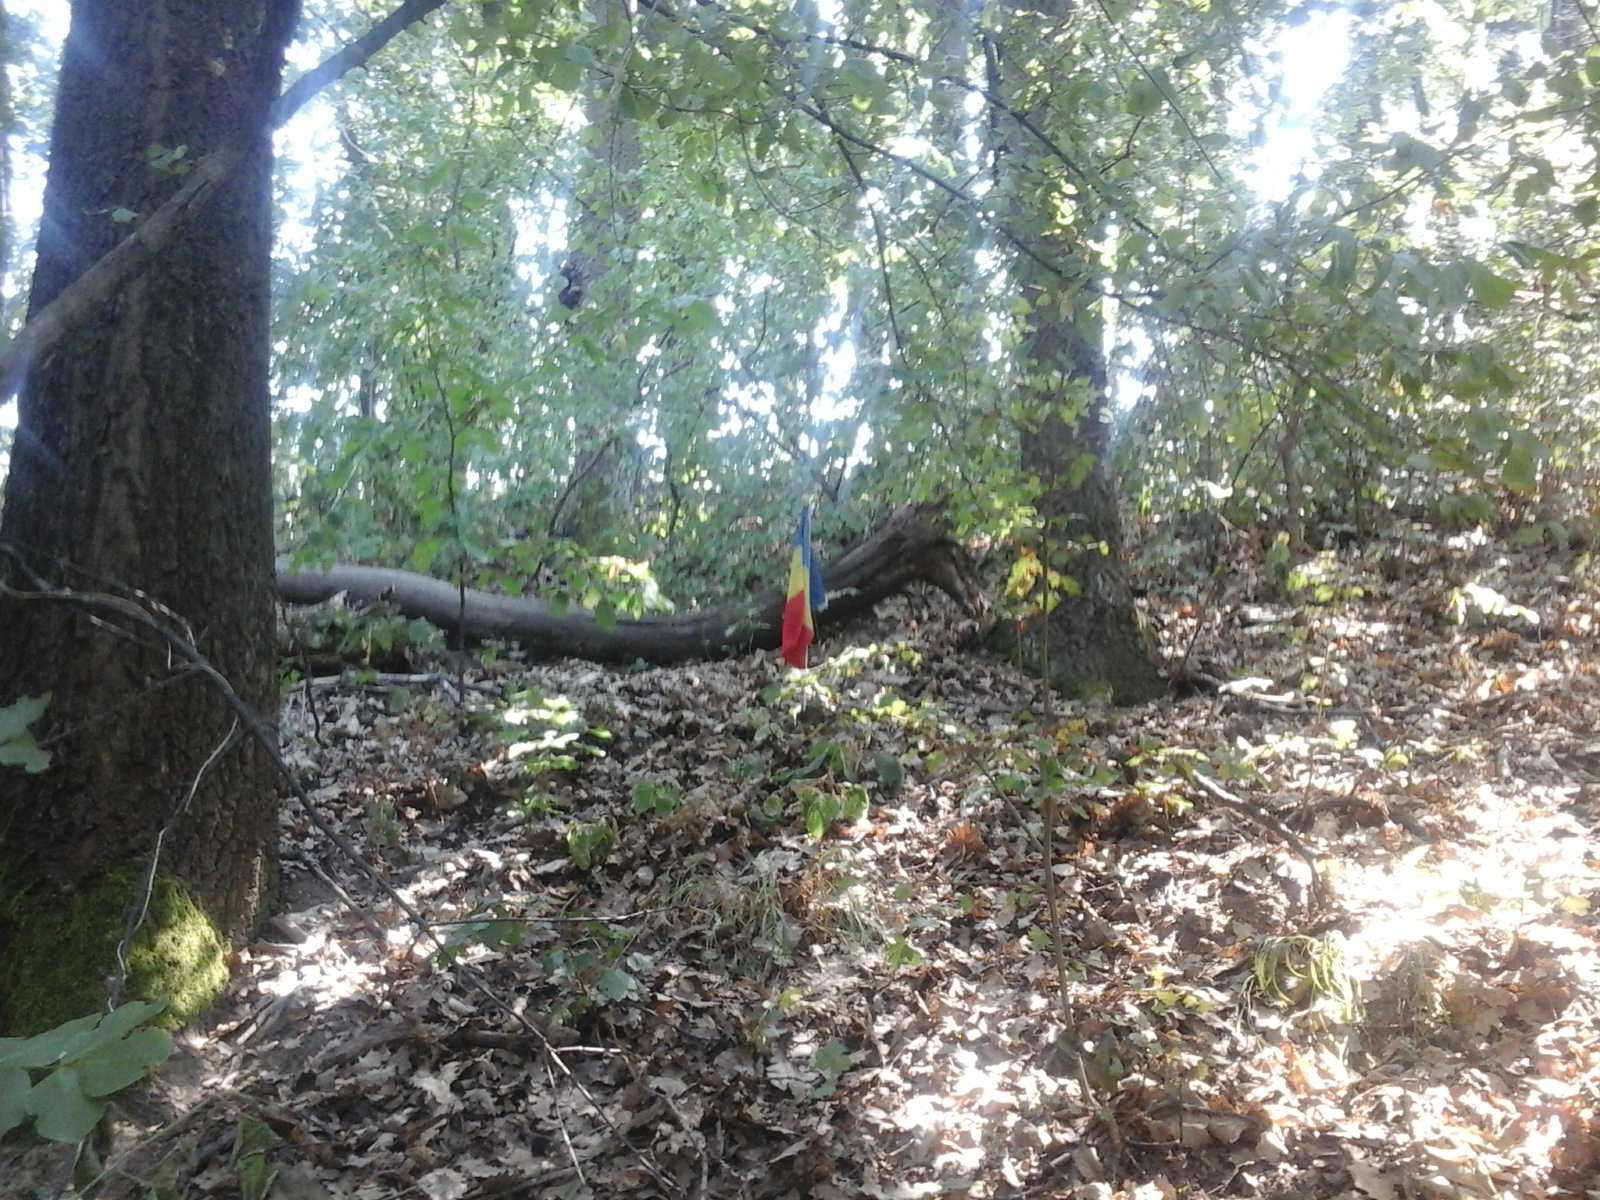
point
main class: Woodland
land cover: Broadleaved woodland
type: acidophilous oak and oak-birch forest
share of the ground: > 75 %
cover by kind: broadleaved forest trees 100 %
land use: Forestry
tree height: > 5 m
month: August
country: RO
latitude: 44.5725
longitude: 23.2597
